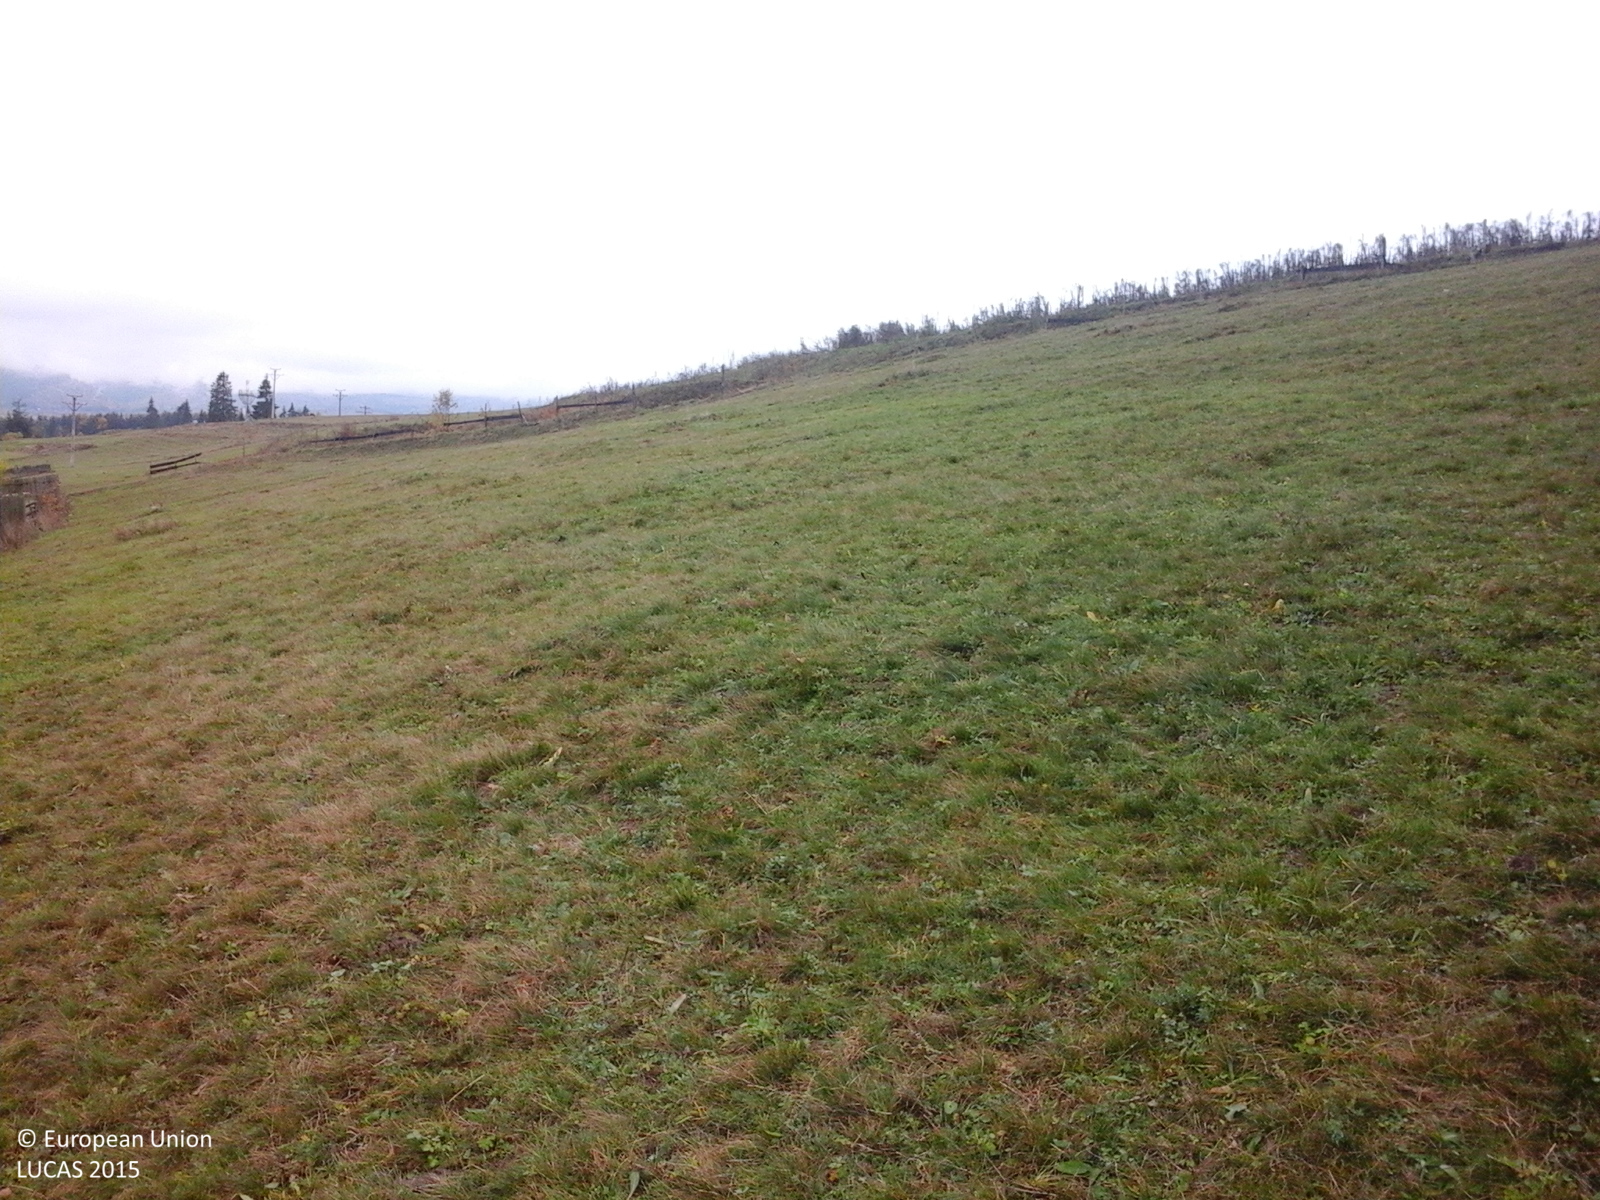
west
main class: Grassland
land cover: Grassland without tree/shrub cover
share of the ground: > 75 %
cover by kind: herbaceous plants 100 %
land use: Agriculture (excluding fallow land and kitchen gardens)
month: October
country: RO
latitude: 46.9373
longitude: 25.3594
